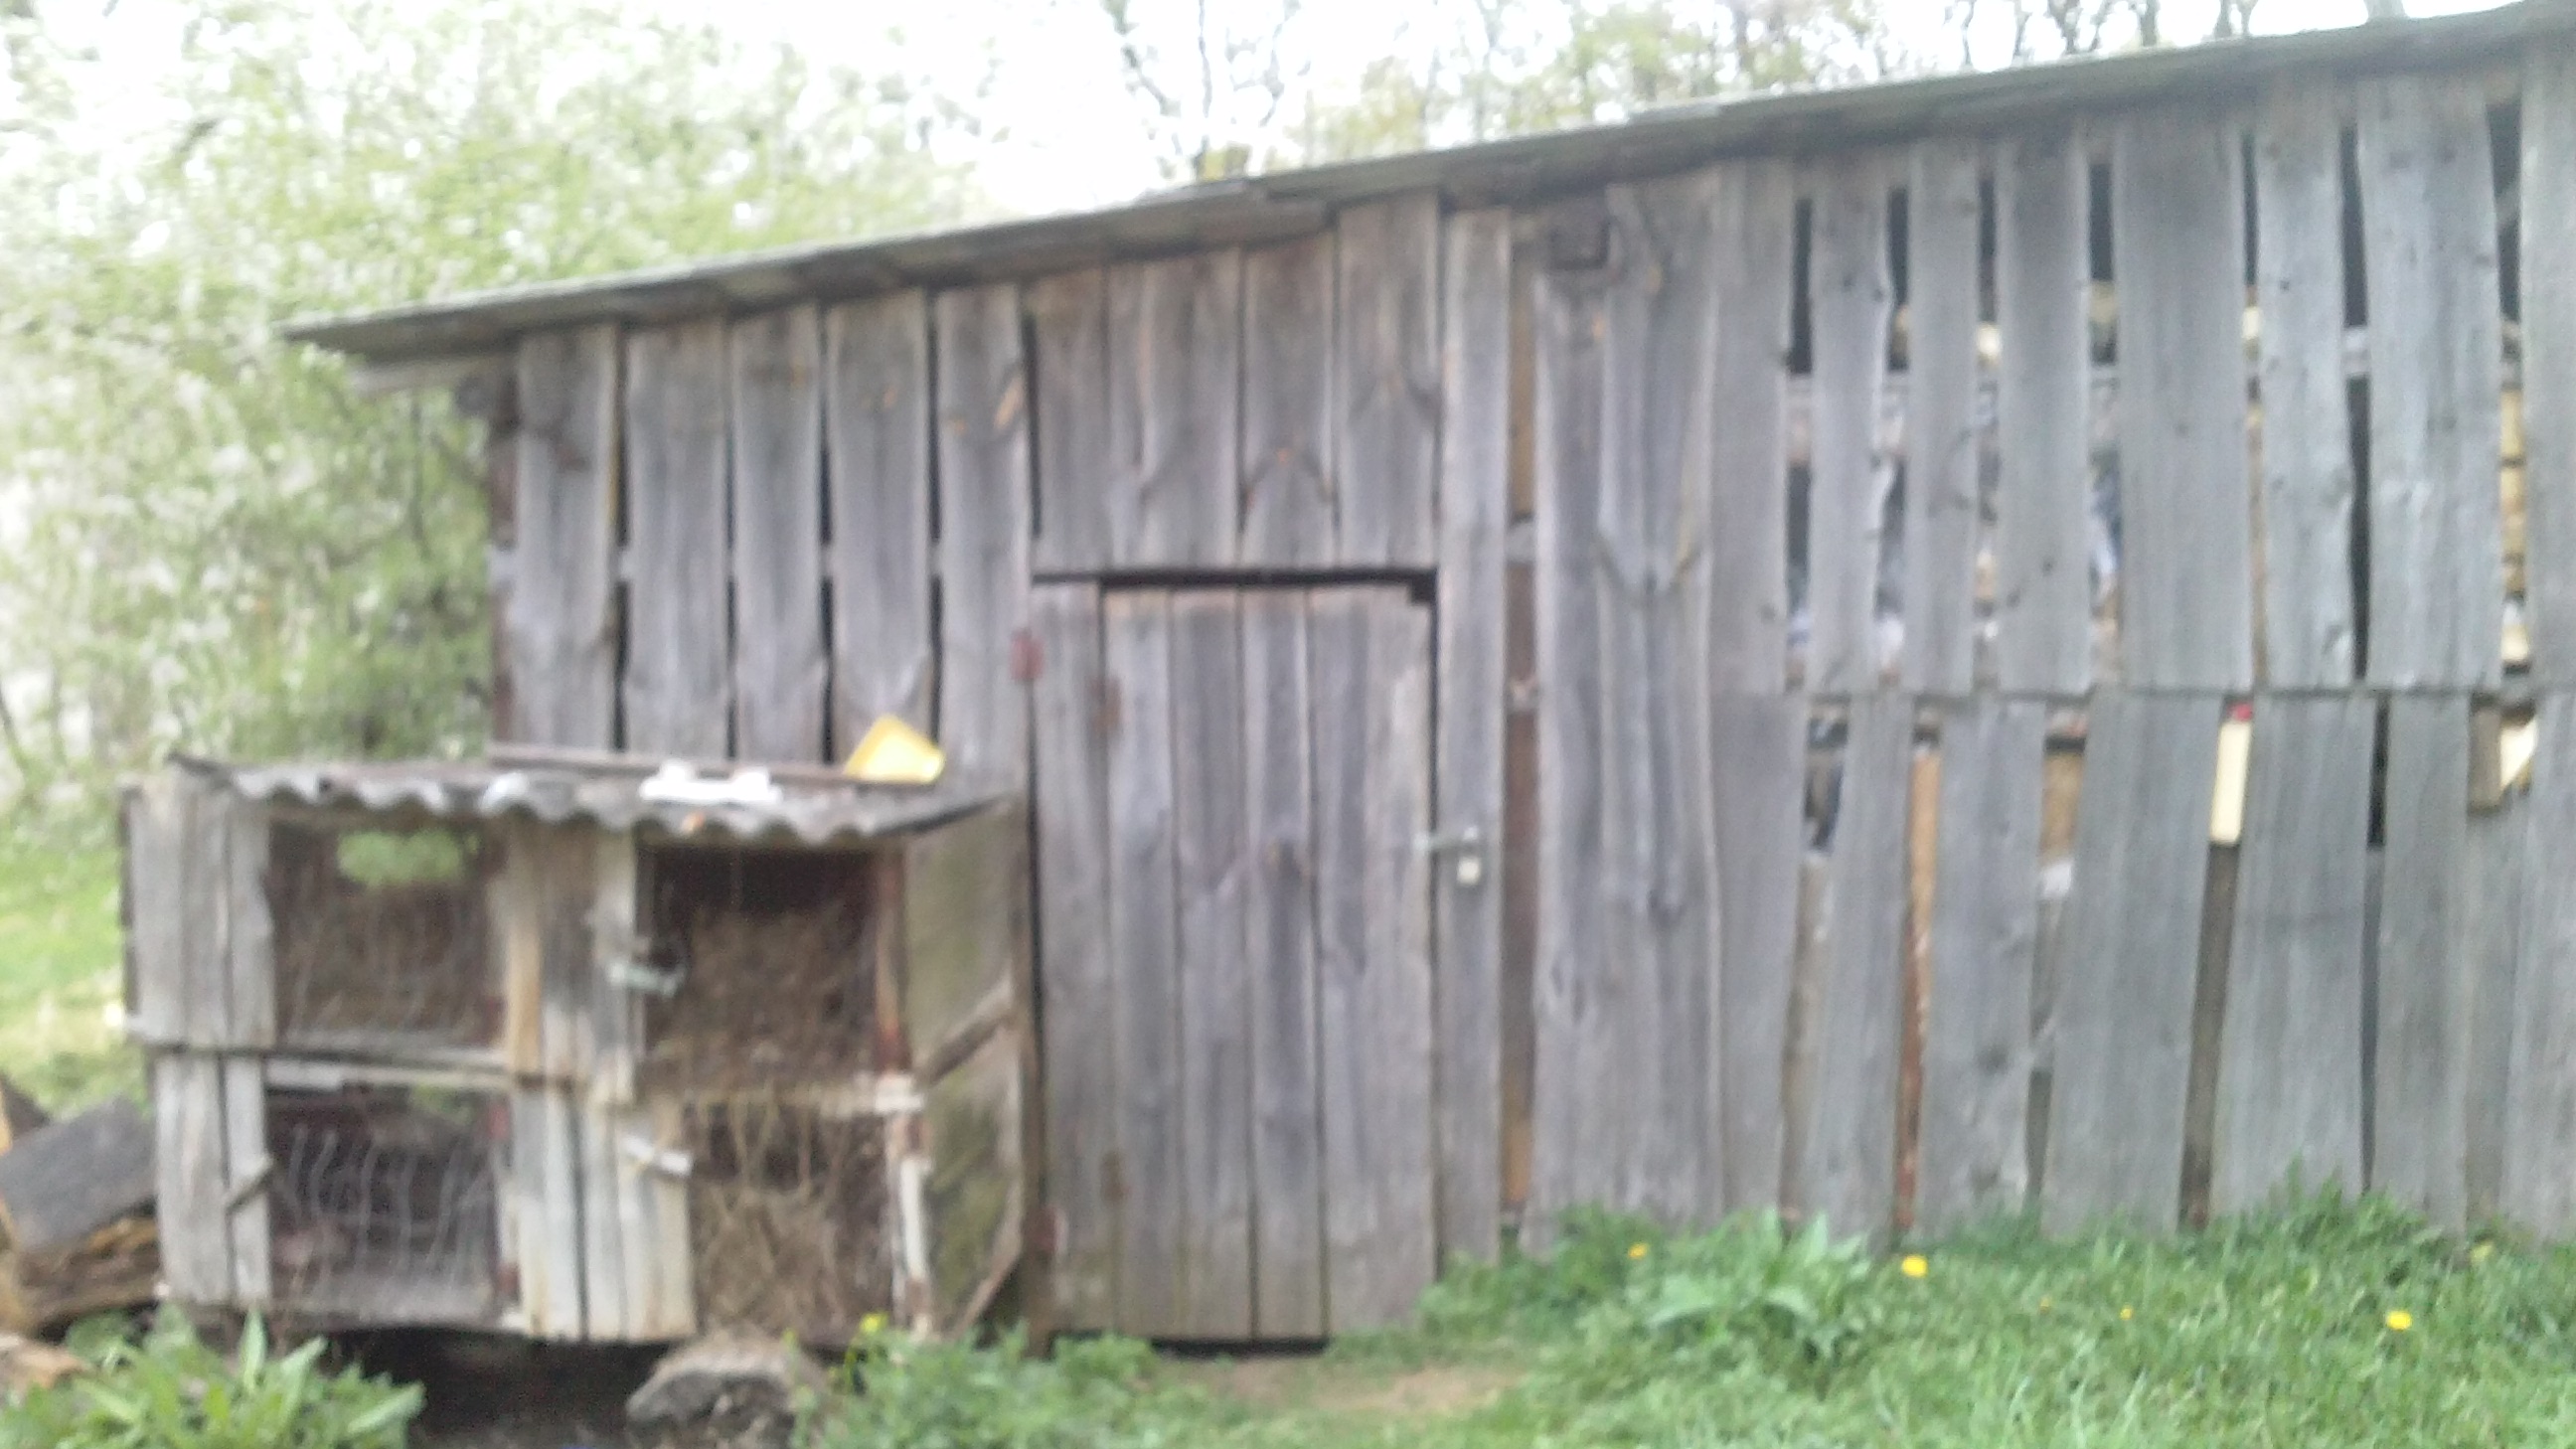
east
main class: Cropland
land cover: Floriculture and ornamental plants
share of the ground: > 75 %
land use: Kitchen garden
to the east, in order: Floriculture and ornamental plants; Artificial constructions in urban areas; Grassland without tree/shrub cover; Broadleaved woodland
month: May
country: LV
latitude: 55.9231
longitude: 27.1496
